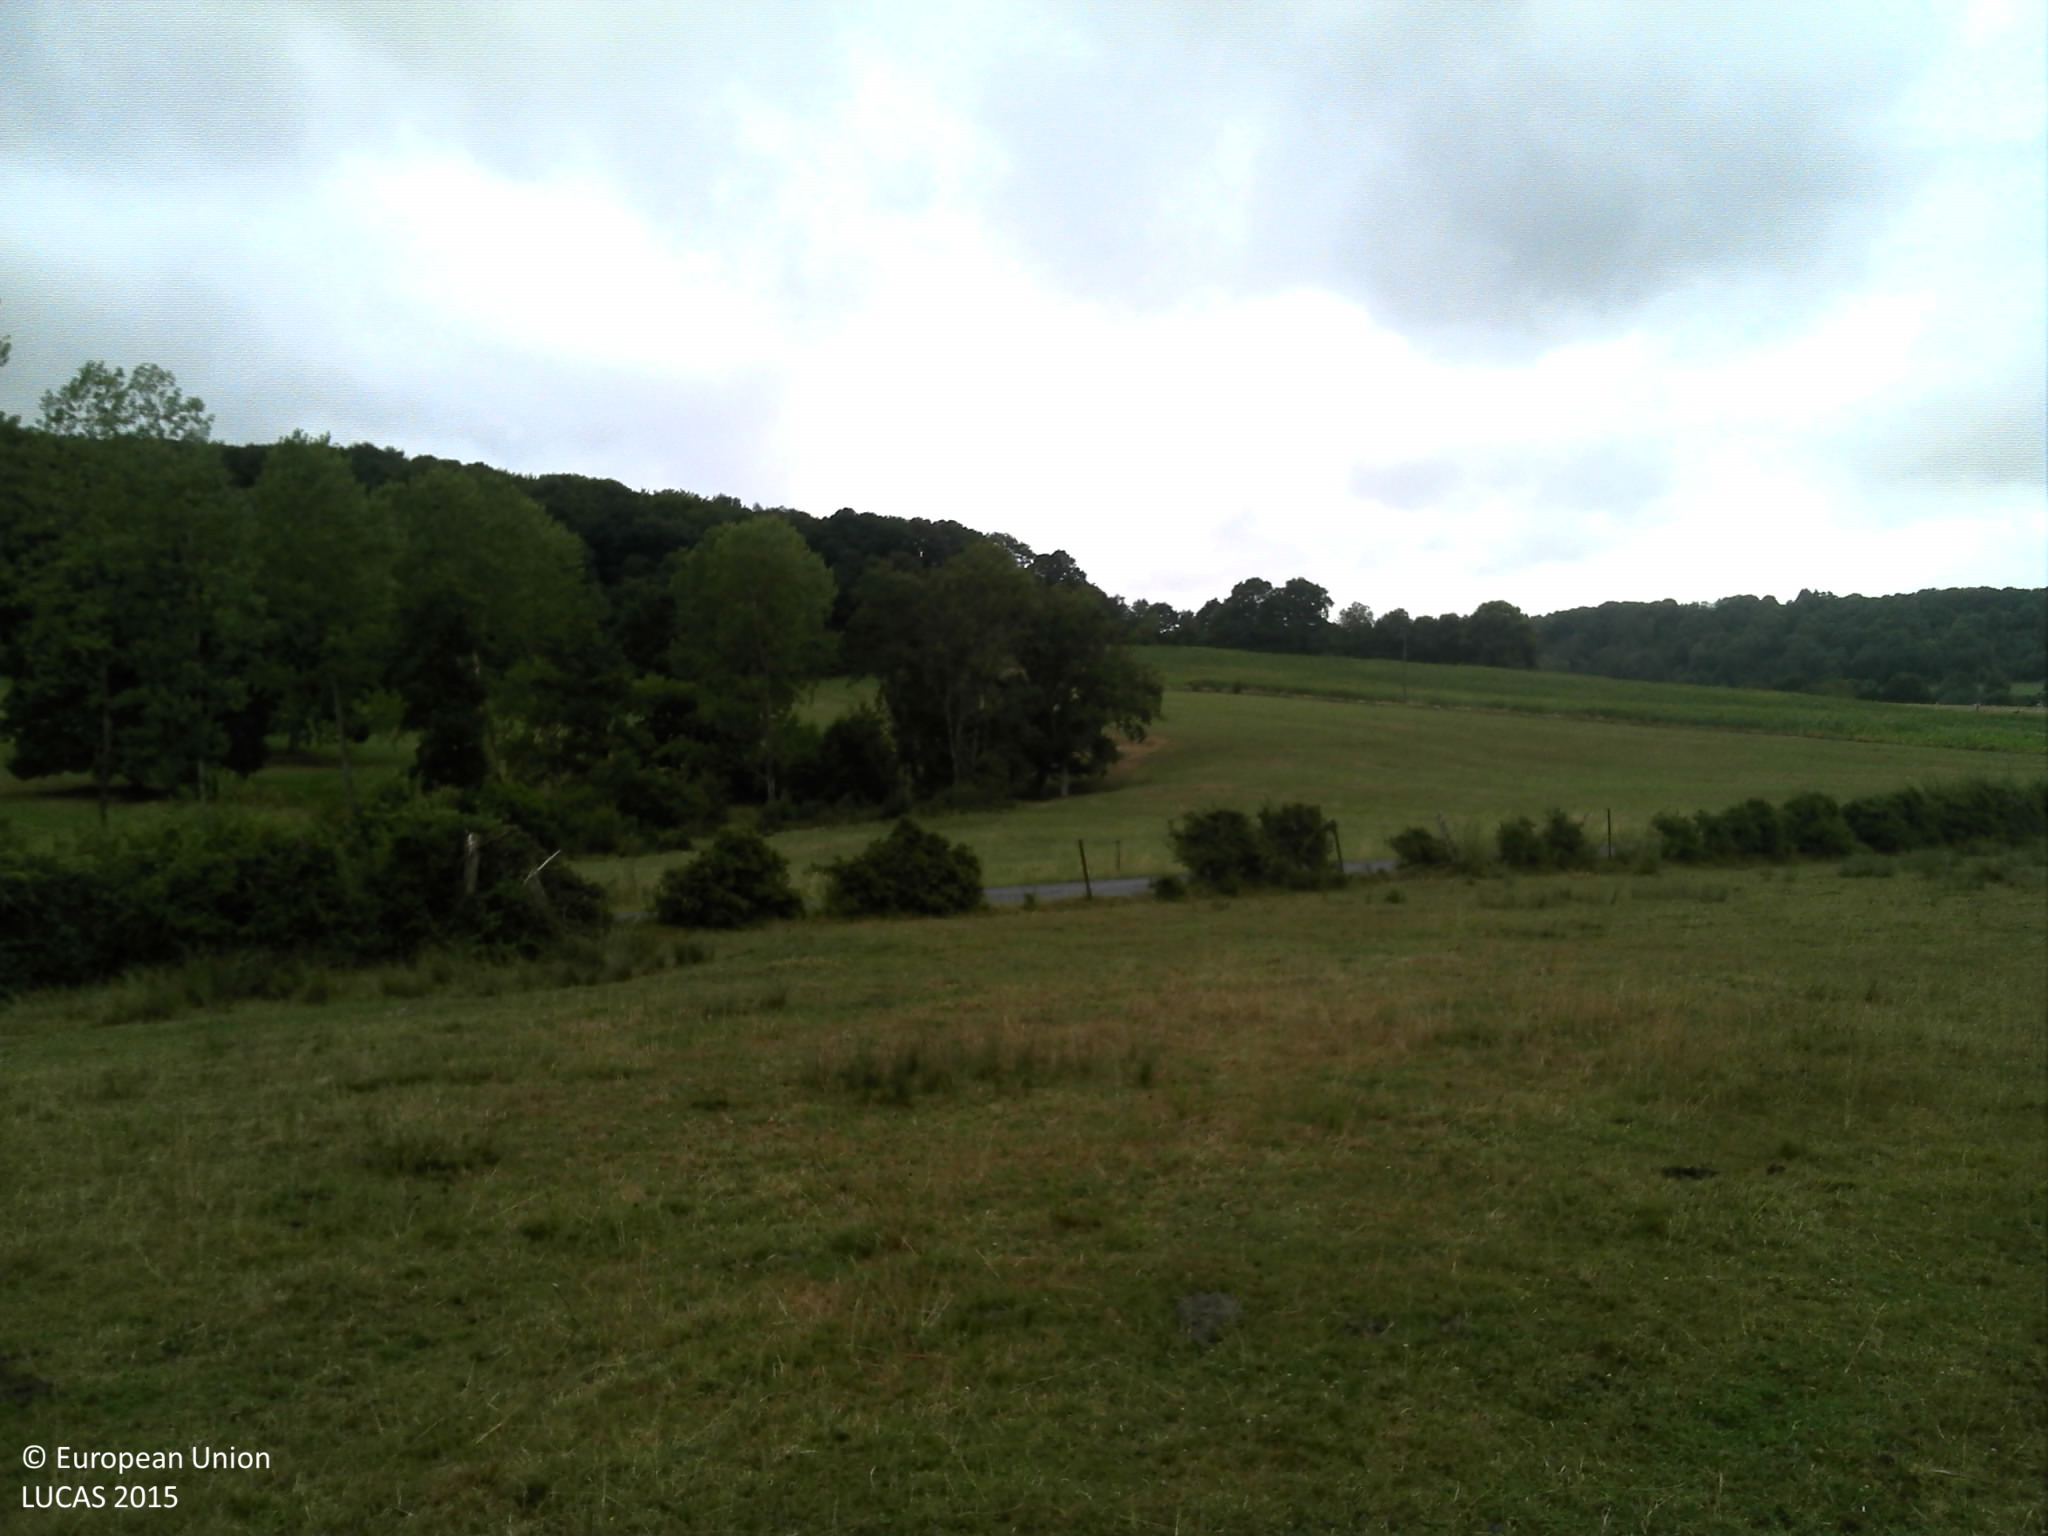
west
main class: Grassland
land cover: Grassland without tree/shrub cover
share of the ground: > 75 %
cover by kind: herbaceous plants 100 %
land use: Agriculture (excluding fallow land and kitchen gardens)
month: July
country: FR
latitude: 49.4335
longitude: 4.7709
